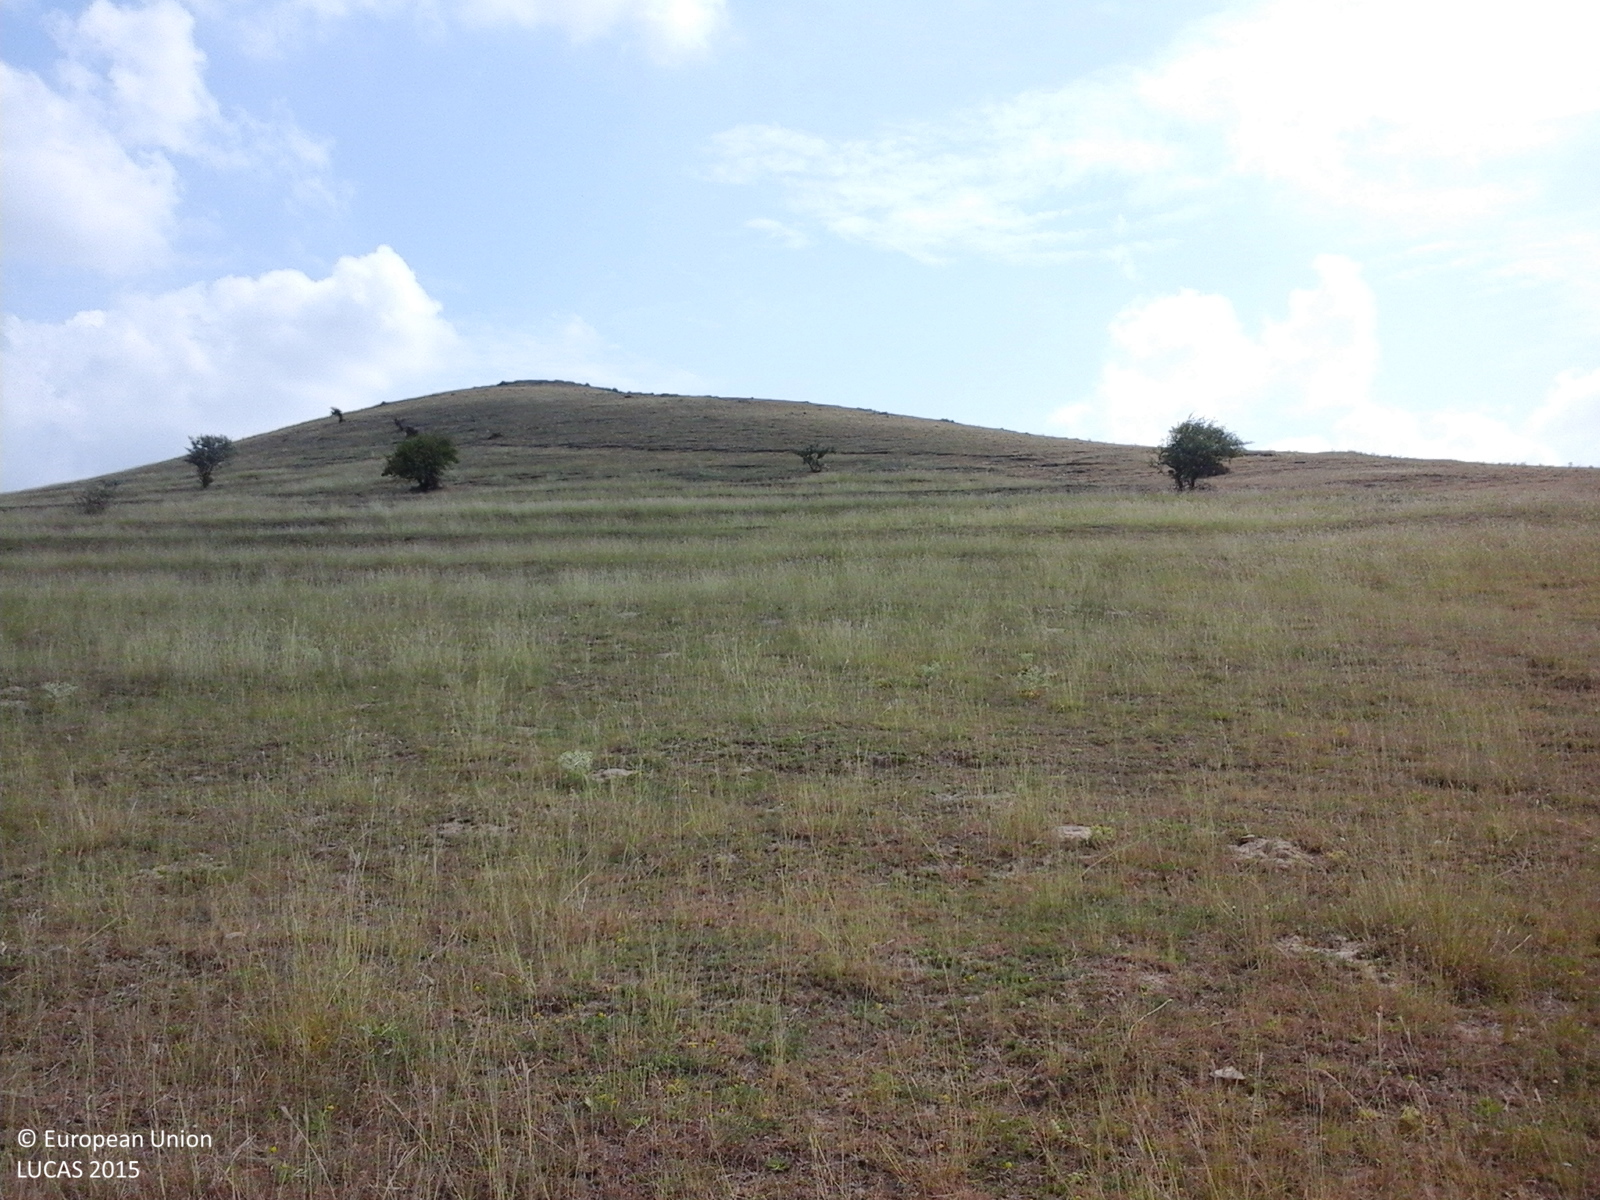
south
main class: Grassland
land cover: Grassland without tree/shrub cover
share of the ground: > 75 %
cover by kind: herbaceous plants 100 %
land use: Agriculture (excluding fallow land and kitchen gardens)
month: July
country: RO
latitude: 45.1516
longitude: 28.2474
